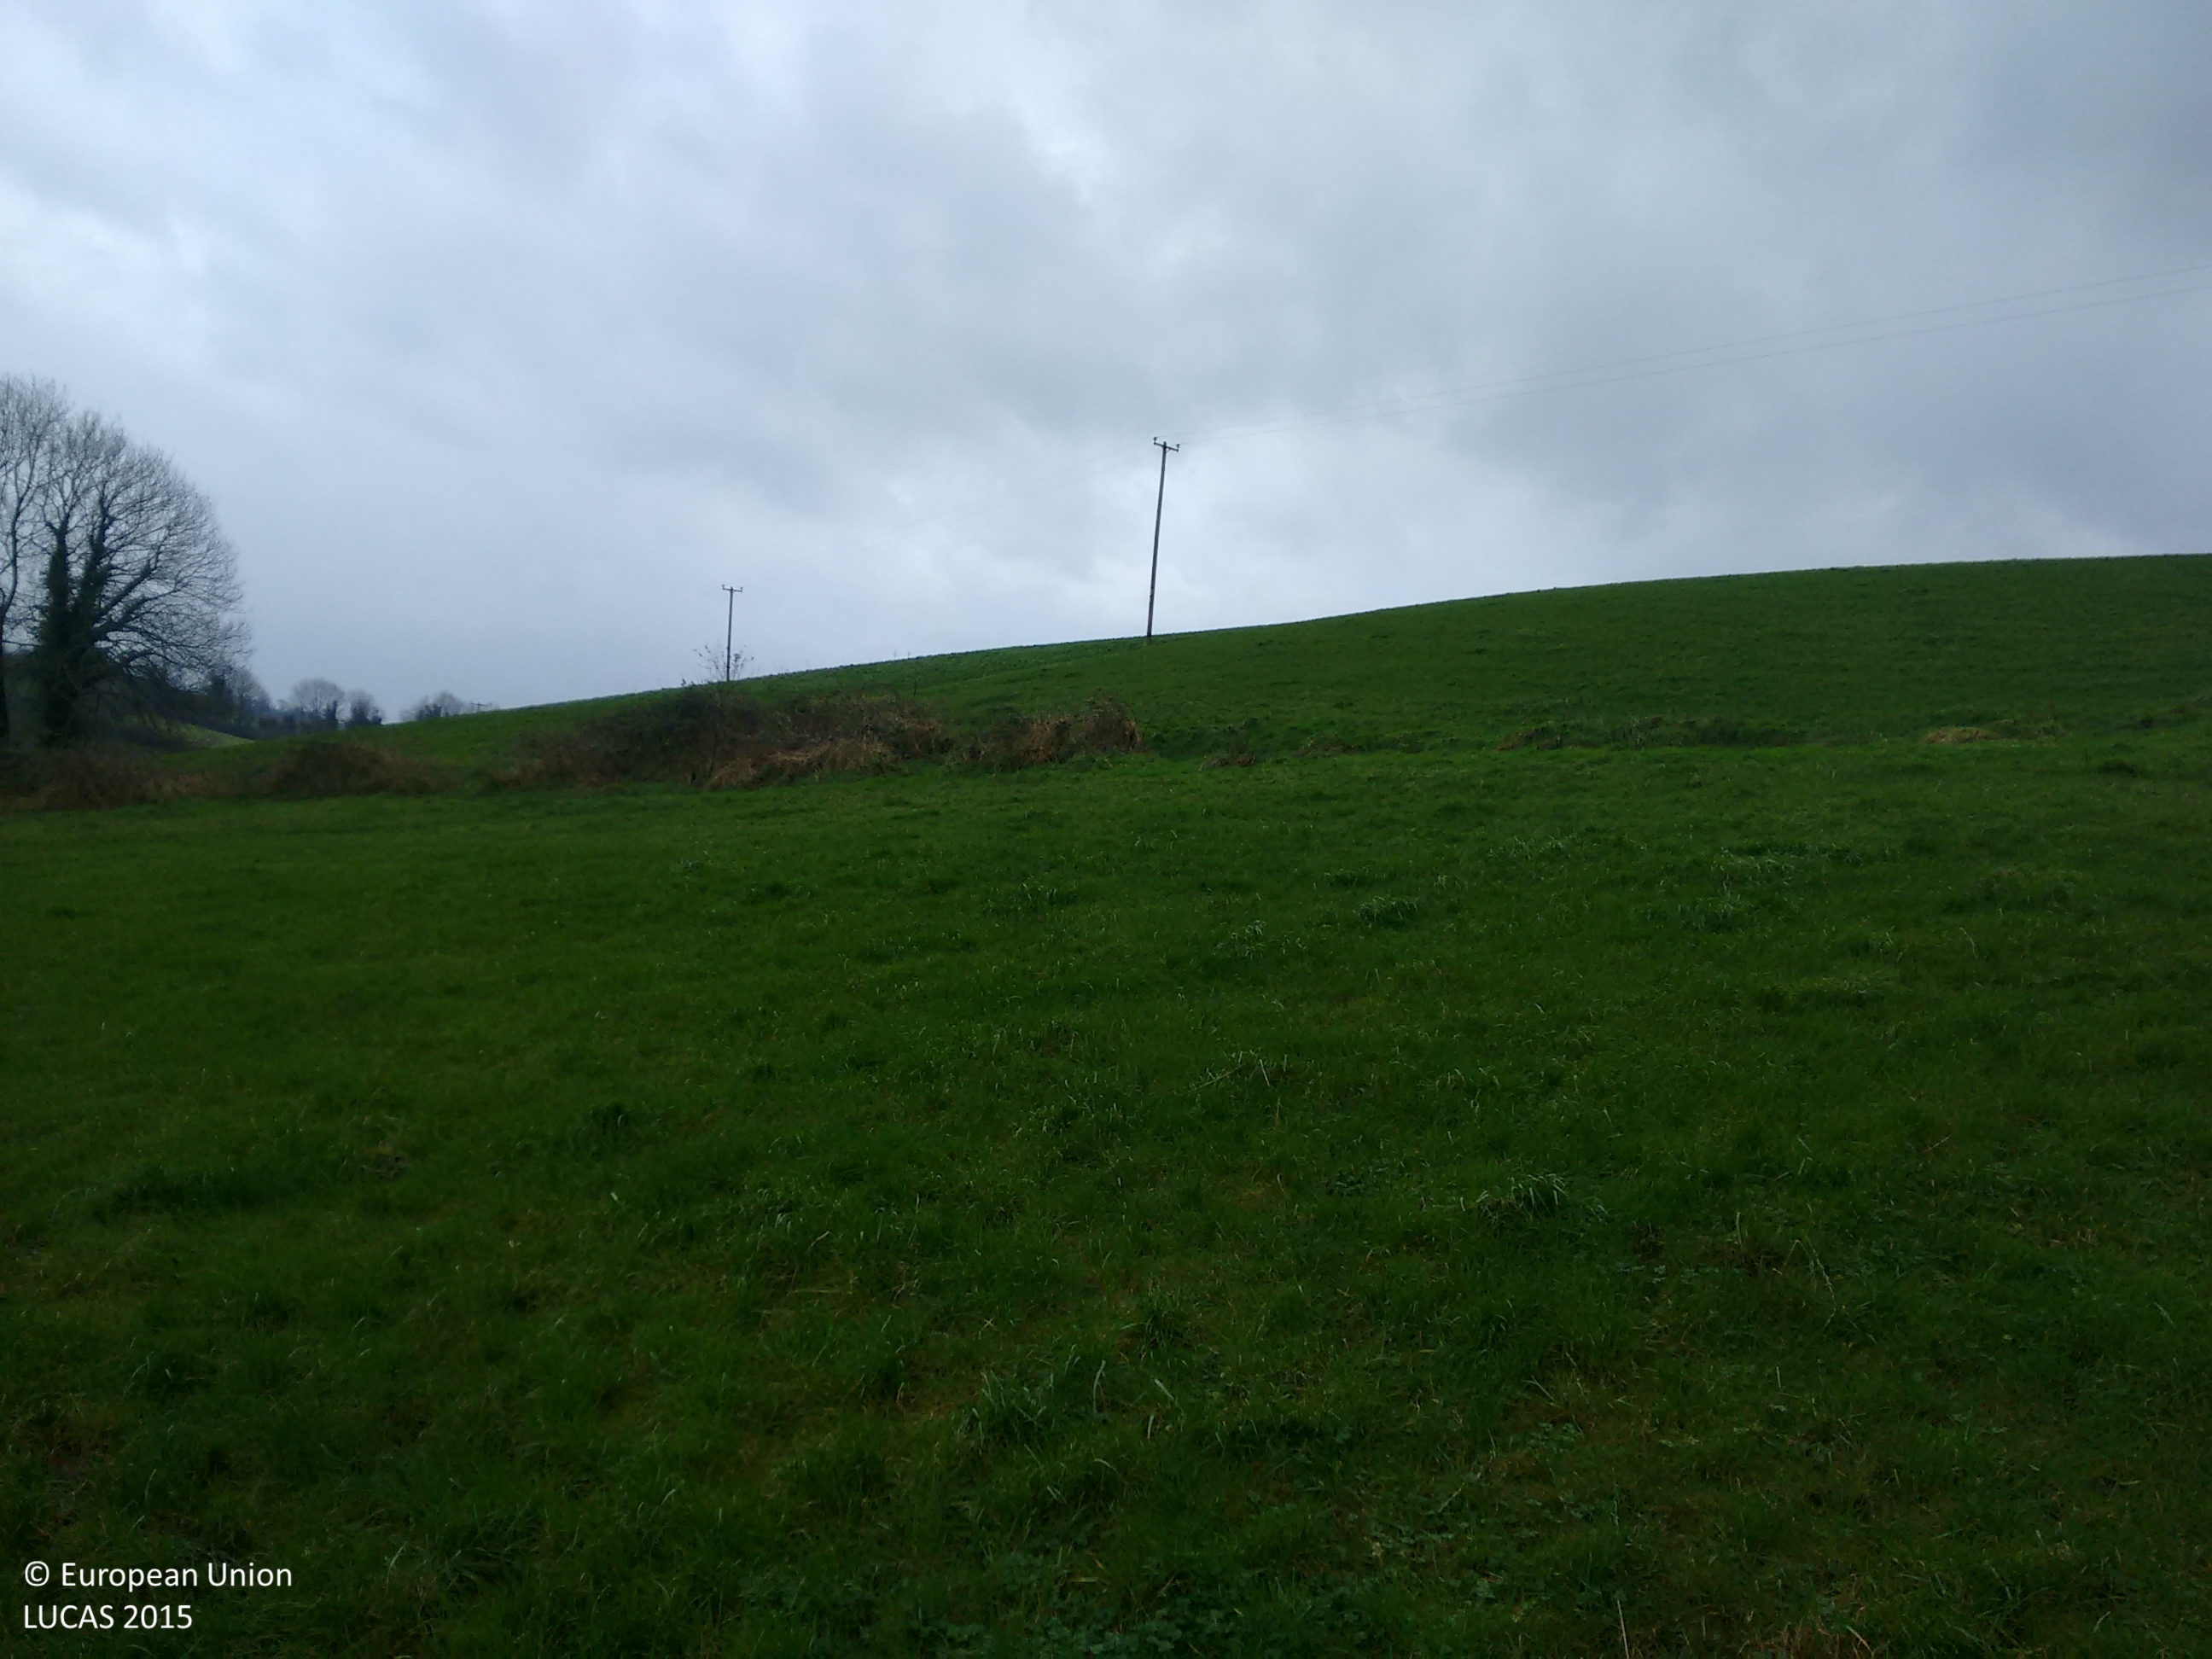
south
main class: Grassland
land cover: Grassland without tree/shrub cover
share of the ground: > 75 %
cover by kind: herbaceous plants 95 %, unconsolidated bare surface 5 %
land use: Agriculture (excluding fallow land and kitchen gardens)
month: December
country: IE
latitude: 54.0877
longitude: -7.2243
